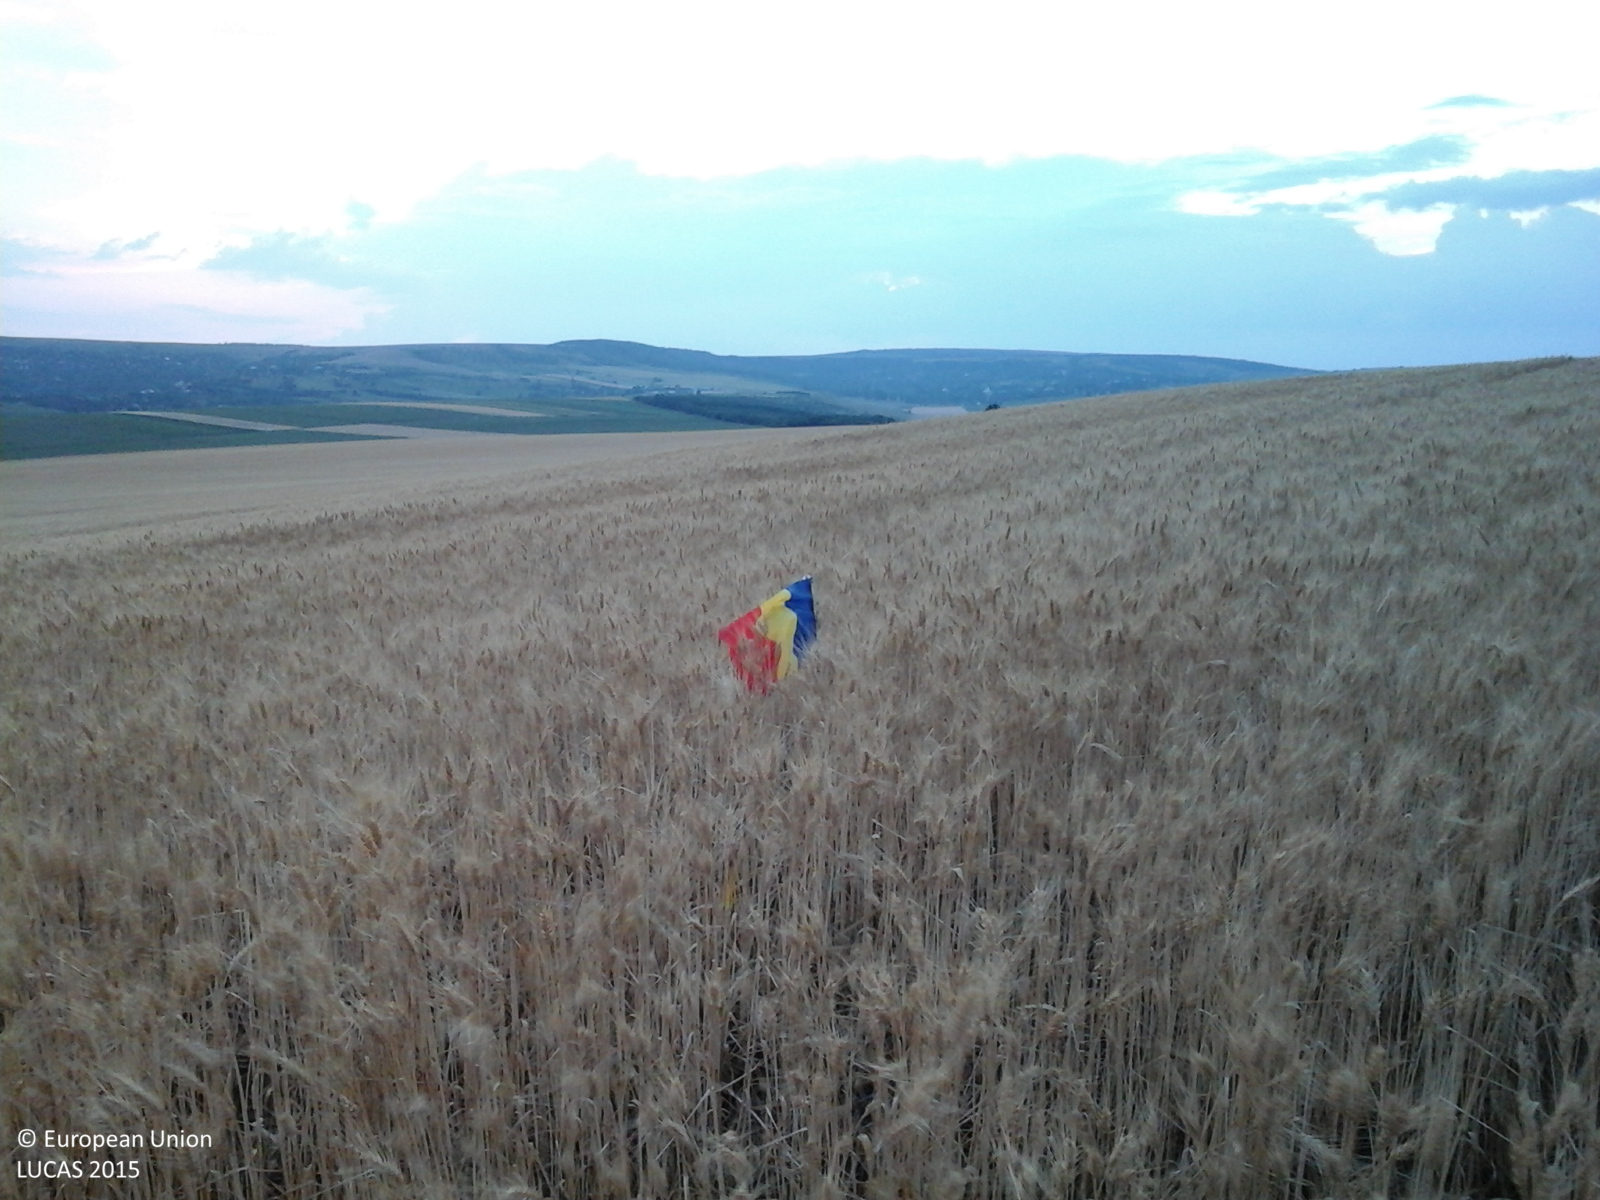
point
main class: Cropland
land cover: Common wheat
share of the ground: > 75 %
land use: Agriculture (excluding fallow land and kitchen gardens)
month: June
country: RO
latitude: 46.7880
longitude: 28.0641
